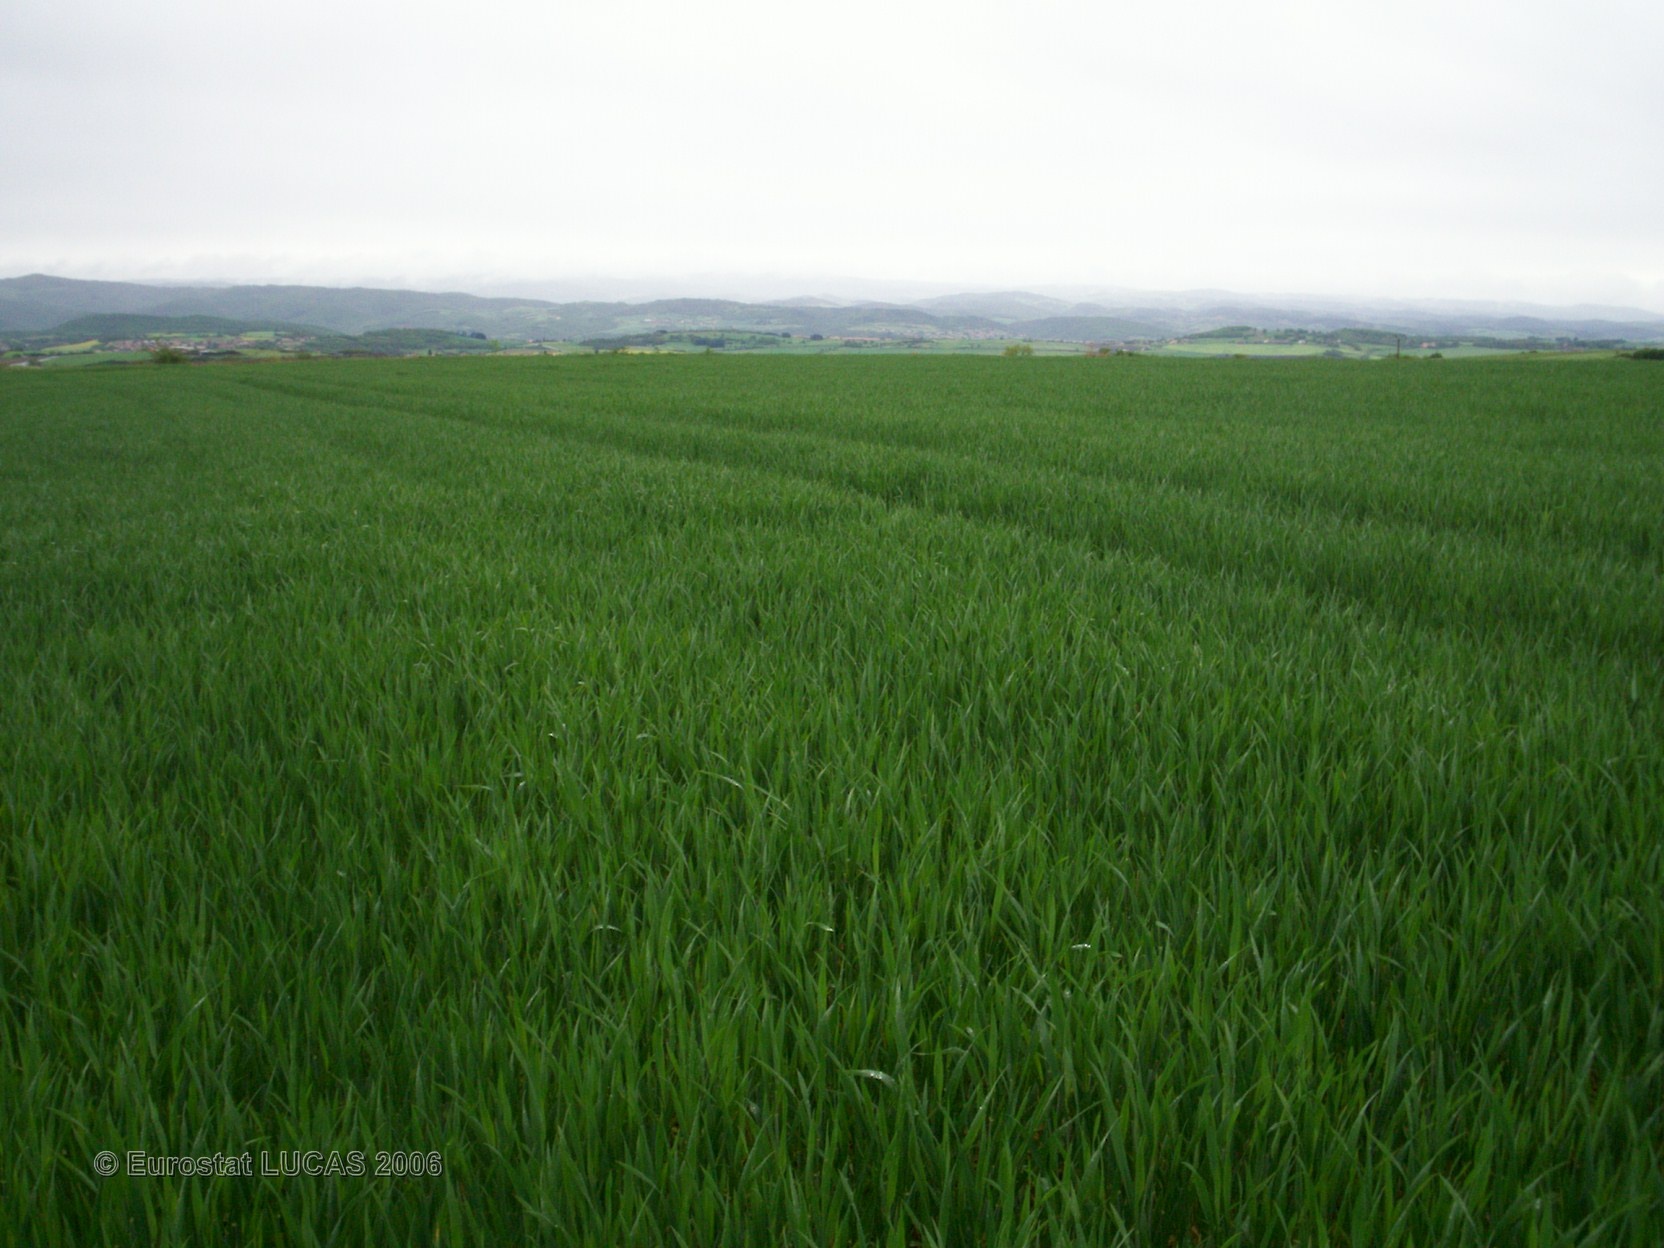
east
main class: Cropland
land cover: Common wheat
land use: Agriculture (excluding fallow land and kitchen gardens)
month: May
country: FR
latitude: 45.4143
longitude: 3.2417
